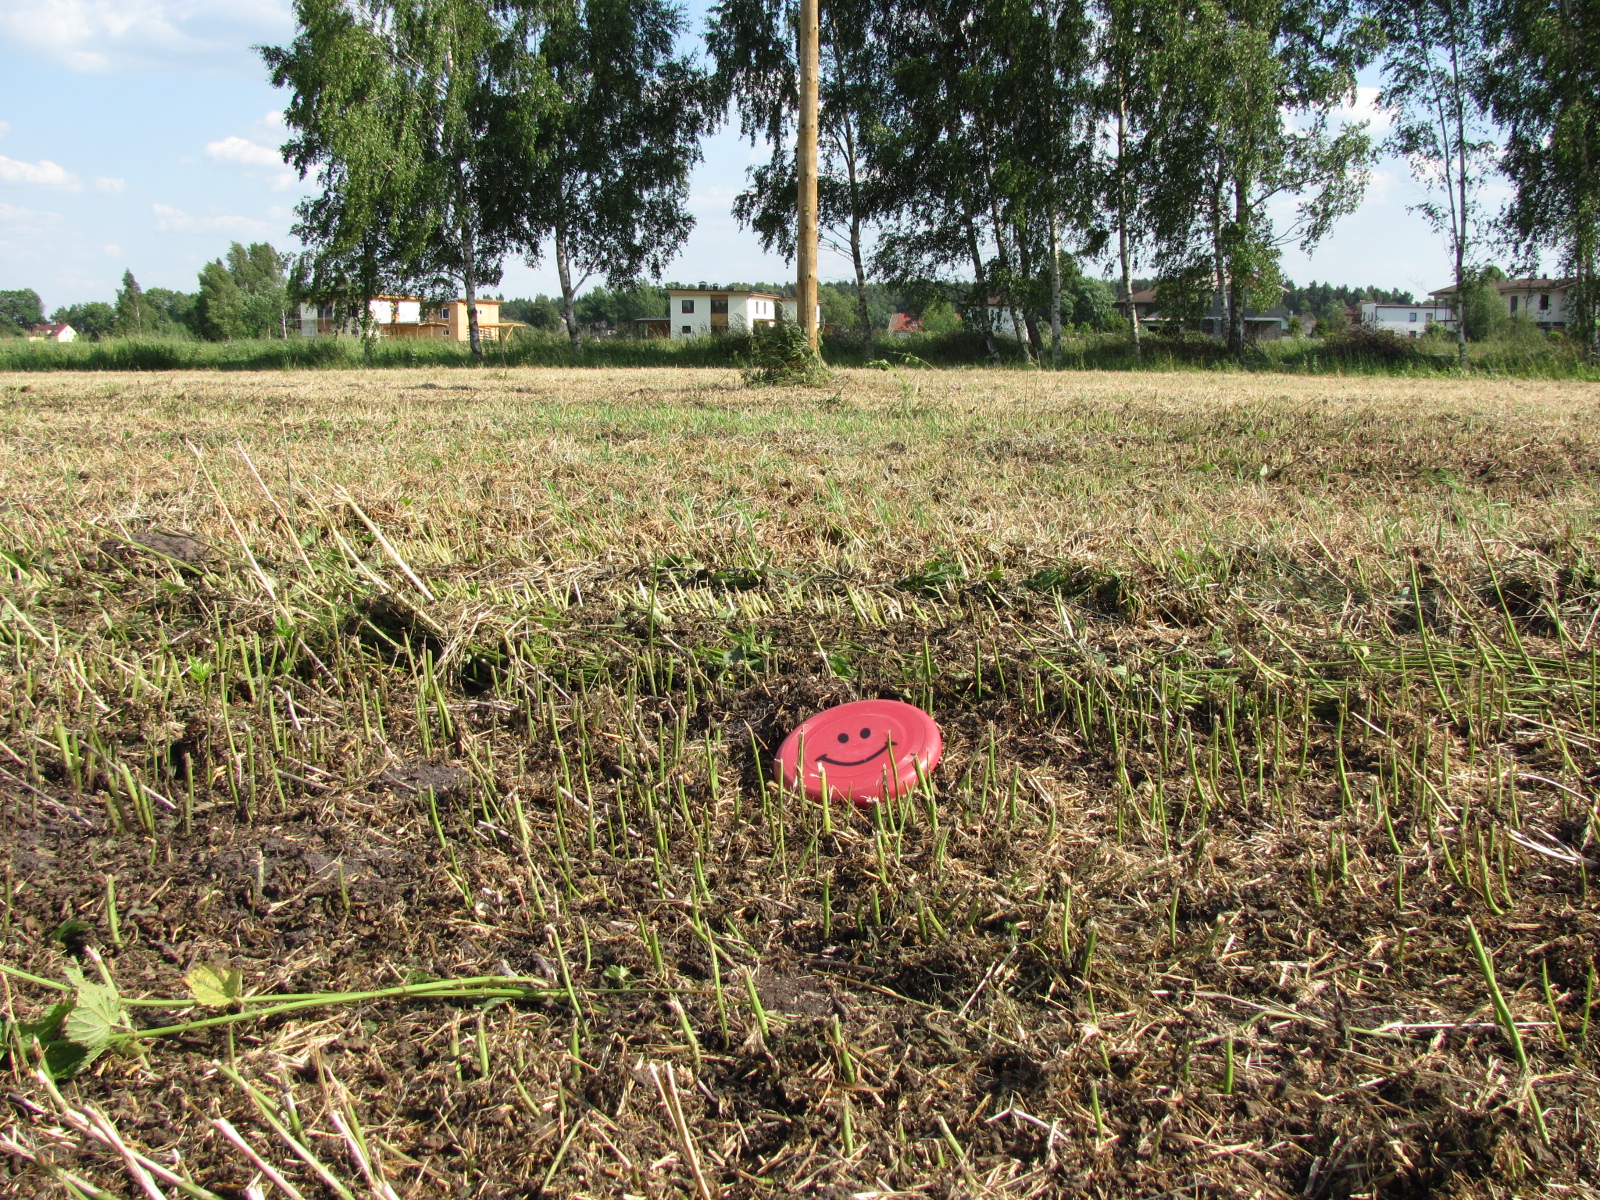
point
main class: Grassland
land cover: Grassland without tree/shrub cover
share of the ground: 10 - 25 %
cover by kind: unconsolidated bare surface 85 %, herbaceous plants 15 %
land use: Agriculture (excluding fallow land and kitchen gardens)
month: July
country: LV
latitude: 56.8939
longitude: 24.0209
